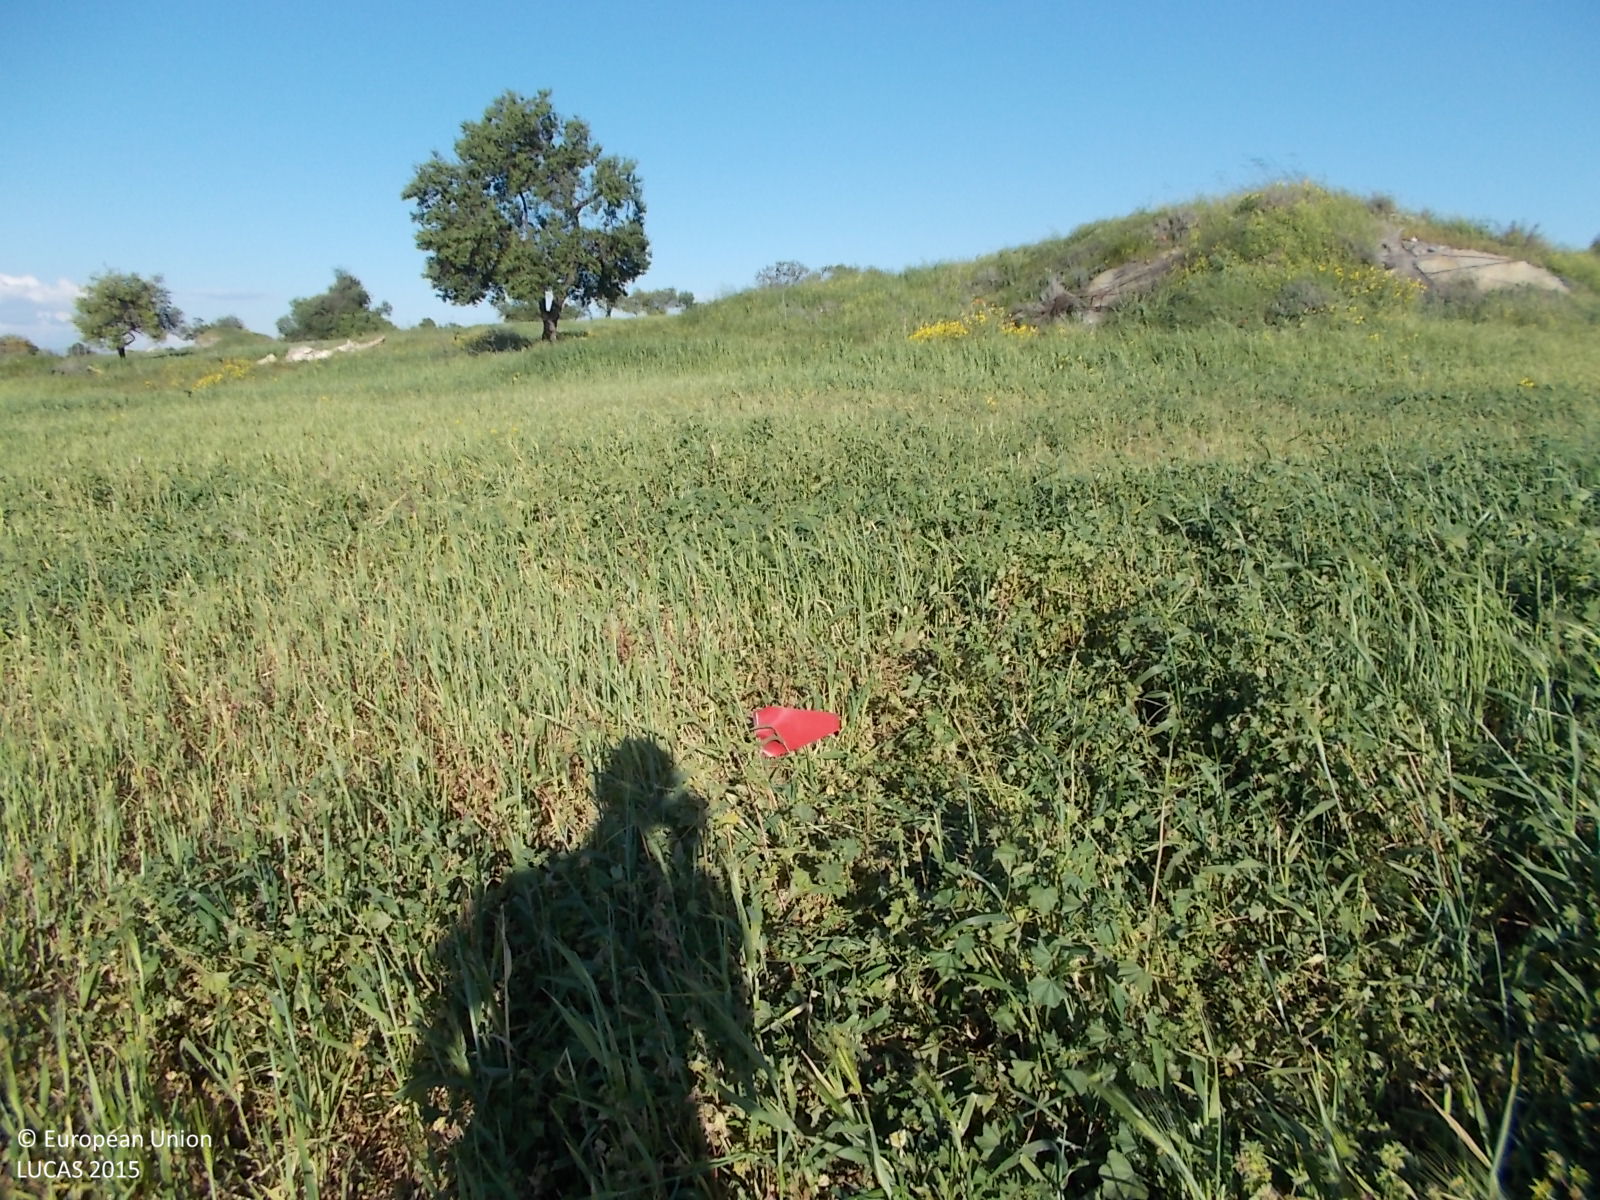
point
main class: Cropland
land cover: Mixed cereals for fodder
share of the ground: > 75 %
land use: Agriculture (excluding fallow land and kitchen gardens)
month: April
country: CY
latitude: 34.9908
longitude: 33.4730
